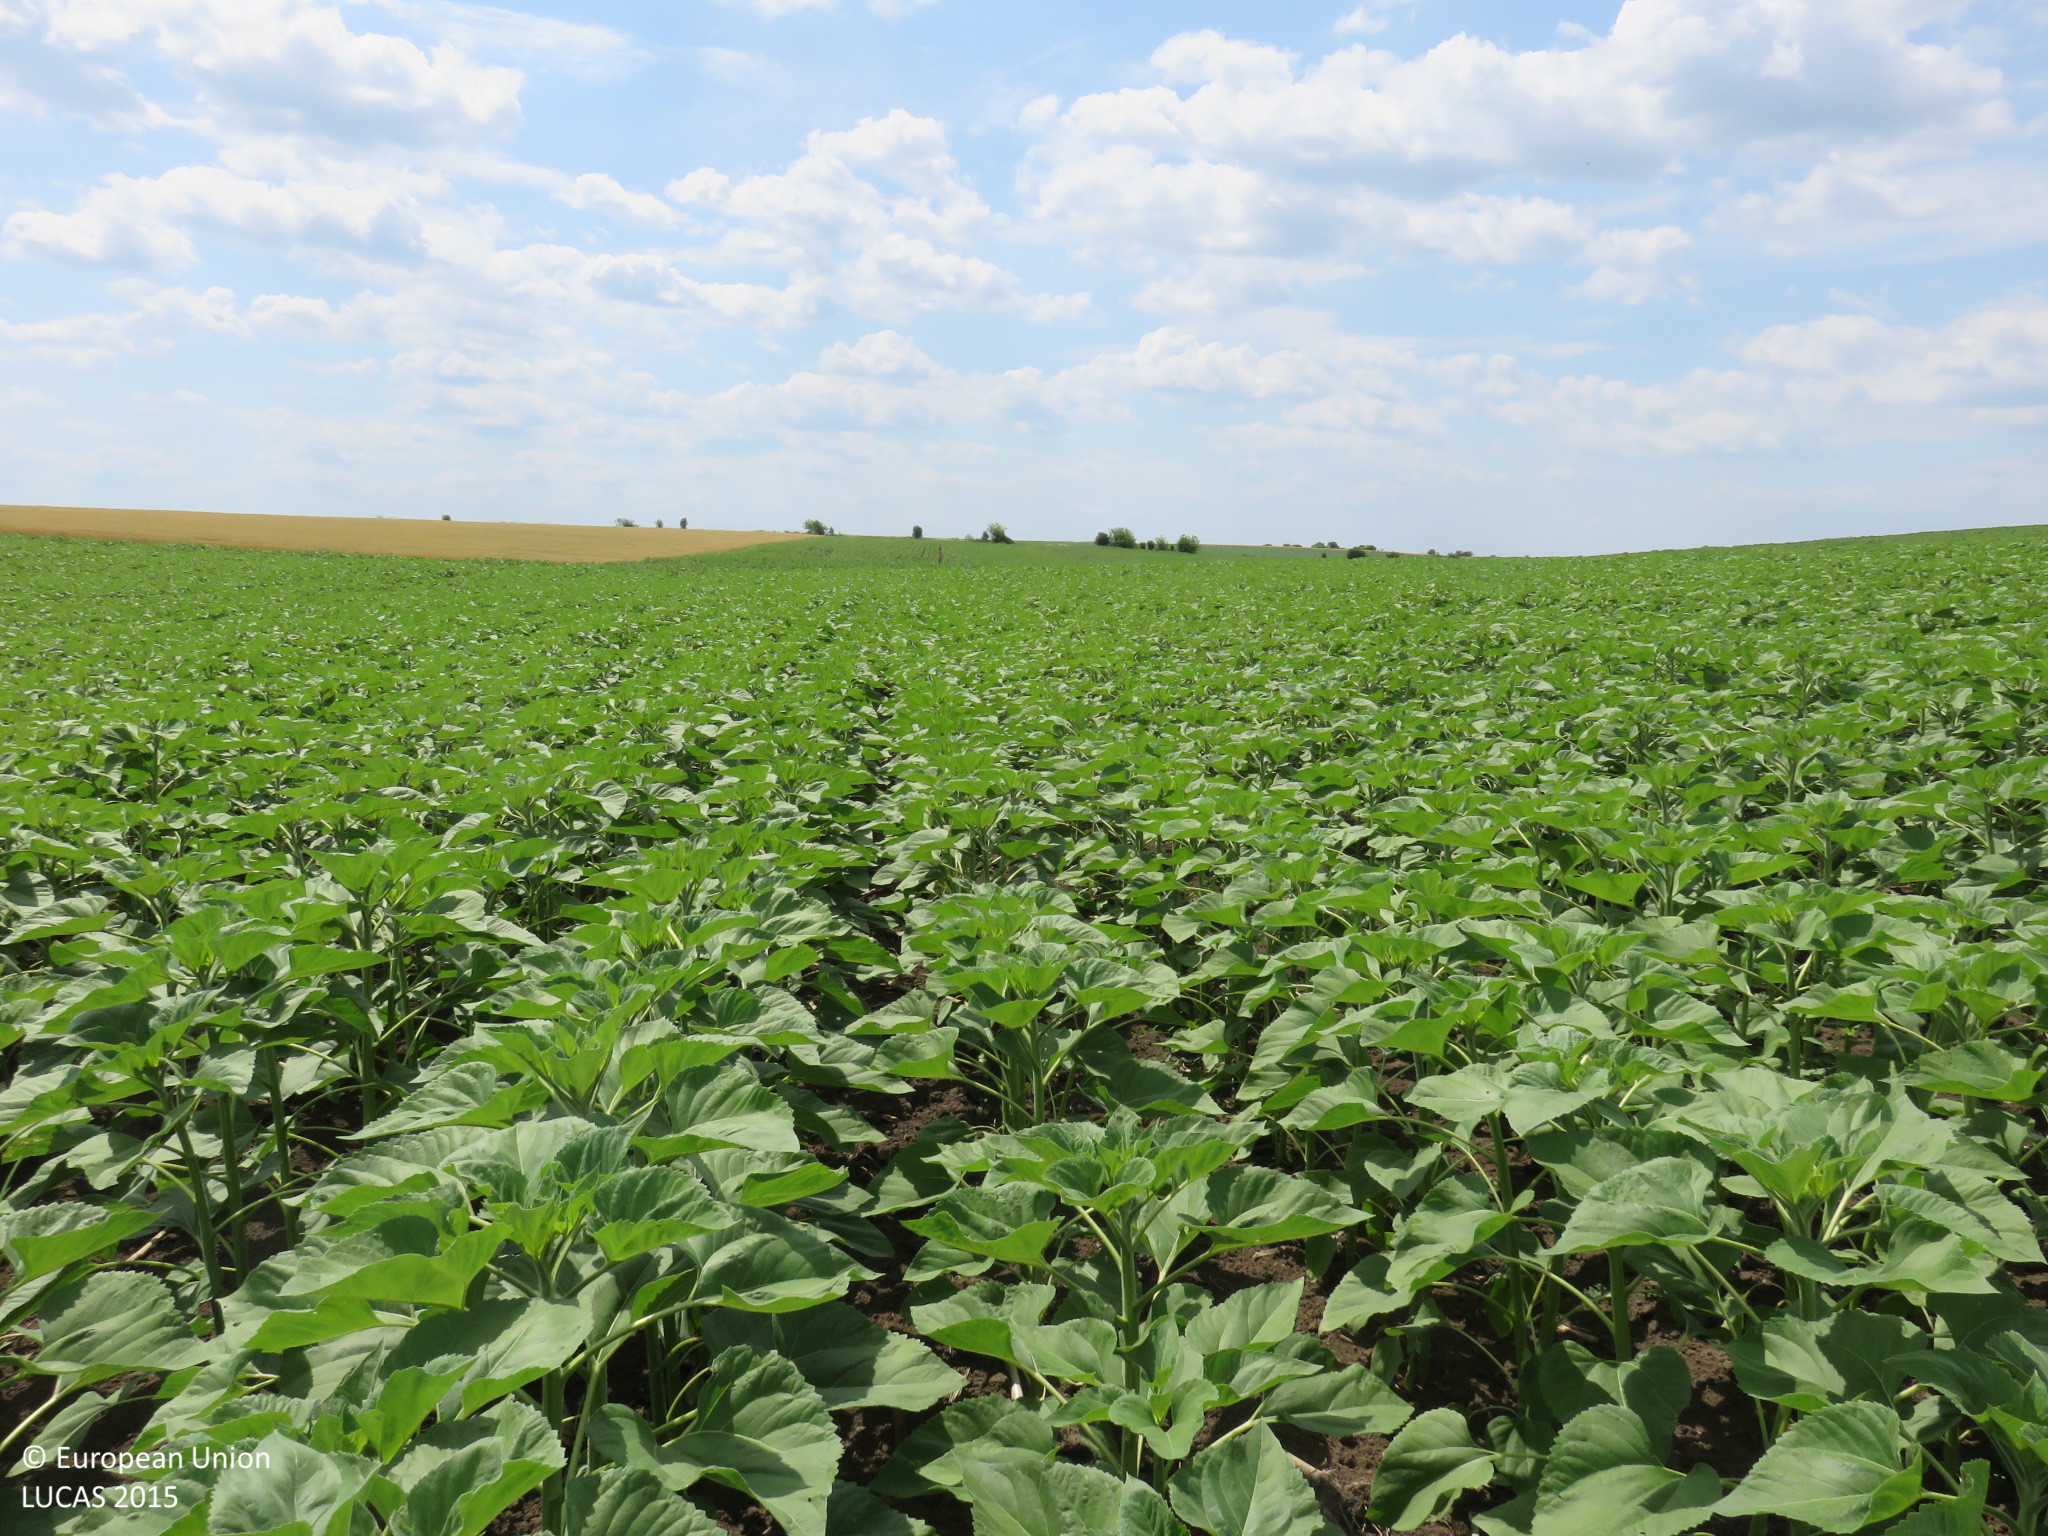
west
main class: Cropland
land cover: Sunflower
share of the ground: > 75 %
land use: Agriculture (excluding fallow land and kitchen gardens)
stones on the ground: < 10 %
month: June
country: BG
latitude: 43.4951
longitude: 24.4679
